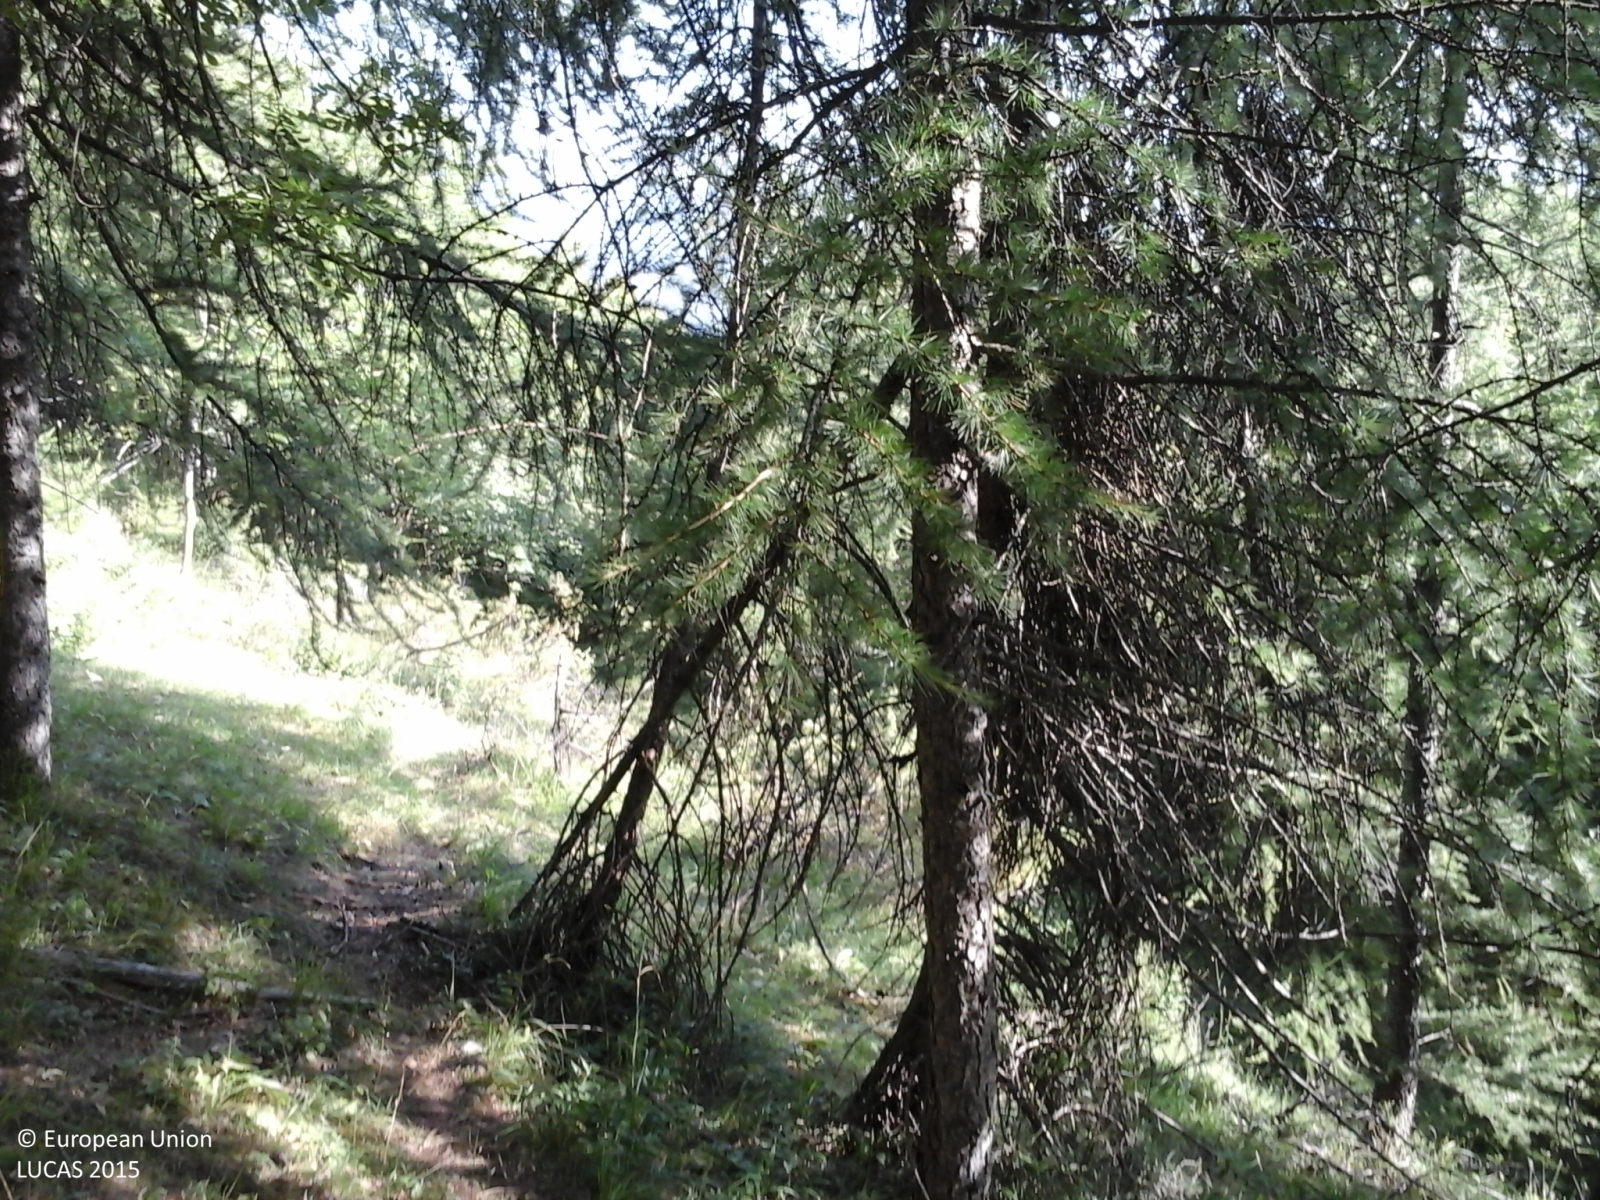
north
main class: Woodland
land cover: Other mixed woodland
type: mesophytic deciduous forest
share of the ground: > 75 %
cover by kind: coniferous forest trees 50 %, broadleaved forest trees 50 %
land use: Forestry
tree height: > 5 m
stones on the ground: < 10 %
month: July
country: IT
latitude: 44.2964
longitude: 7.2609
